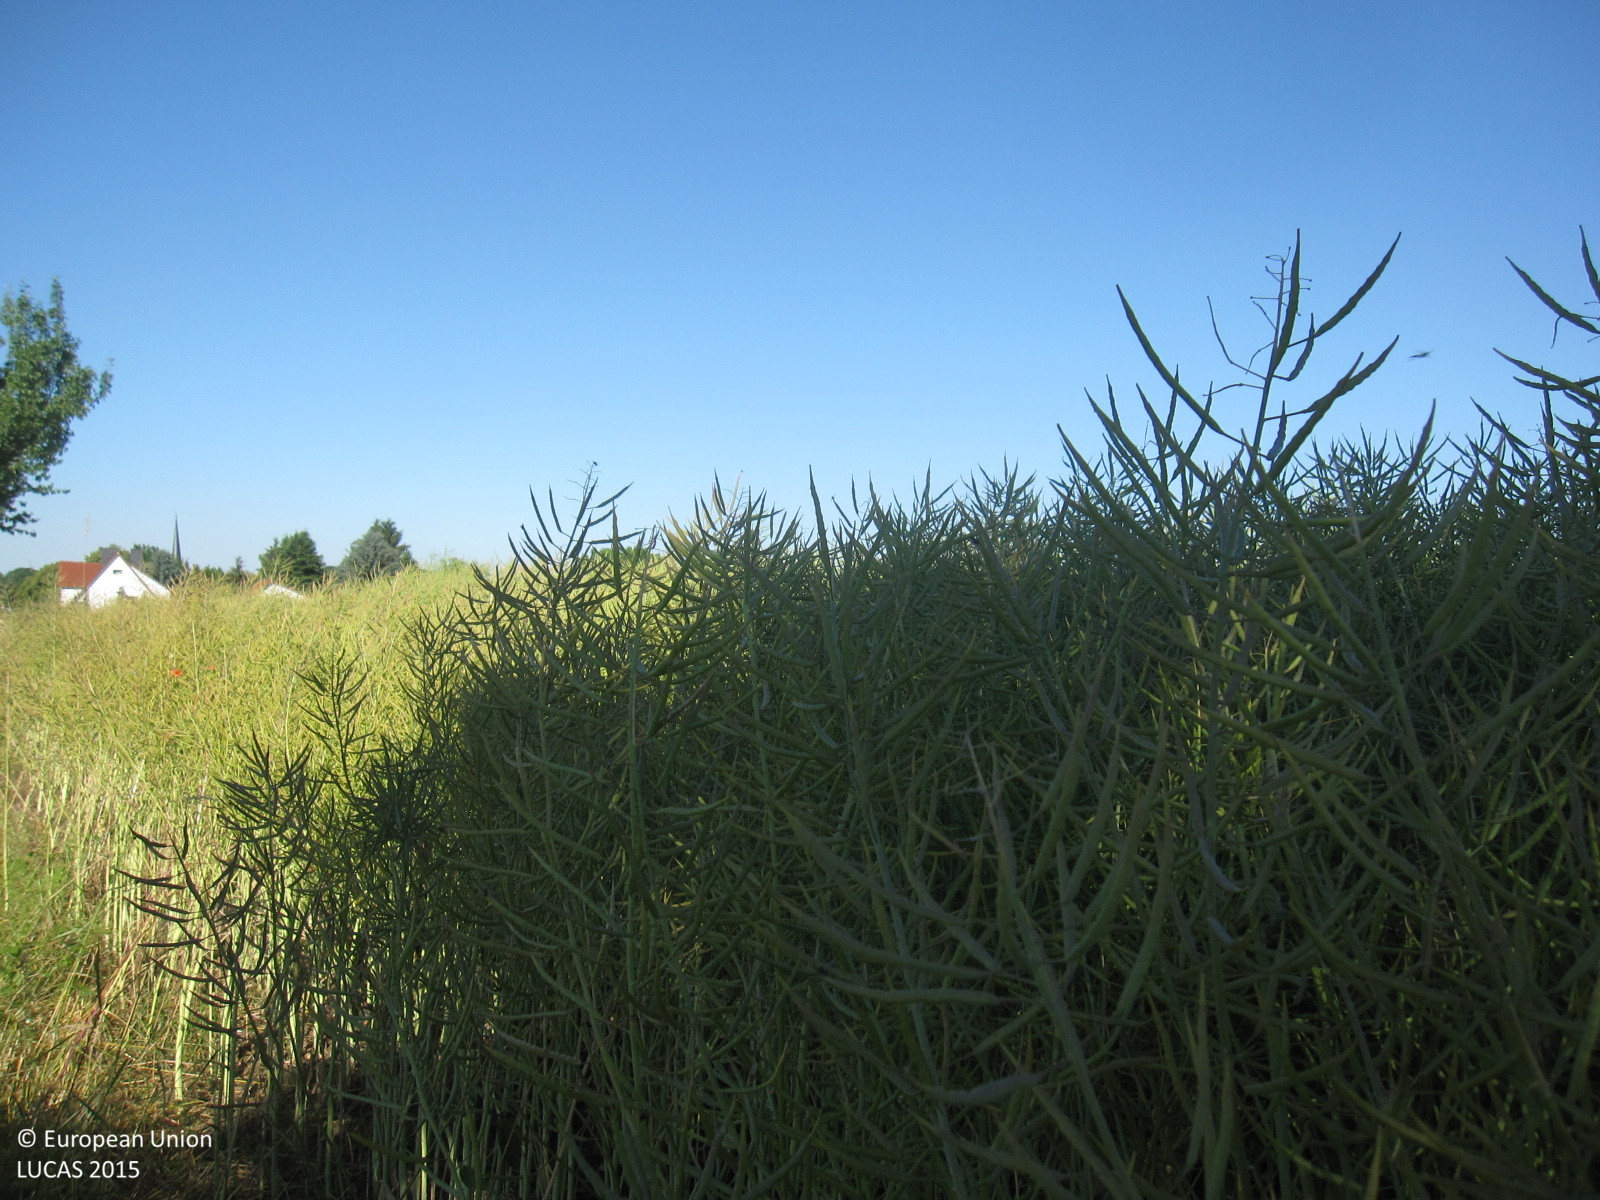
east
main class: Cropland
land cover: Rape and turnip rape
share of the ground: > 75 %
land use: Agriculture (excluding fallow land and kitchen gardens)
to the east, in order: Rape and turnip rape
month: July
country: DE
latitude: 51.1906
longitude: 12.0744
